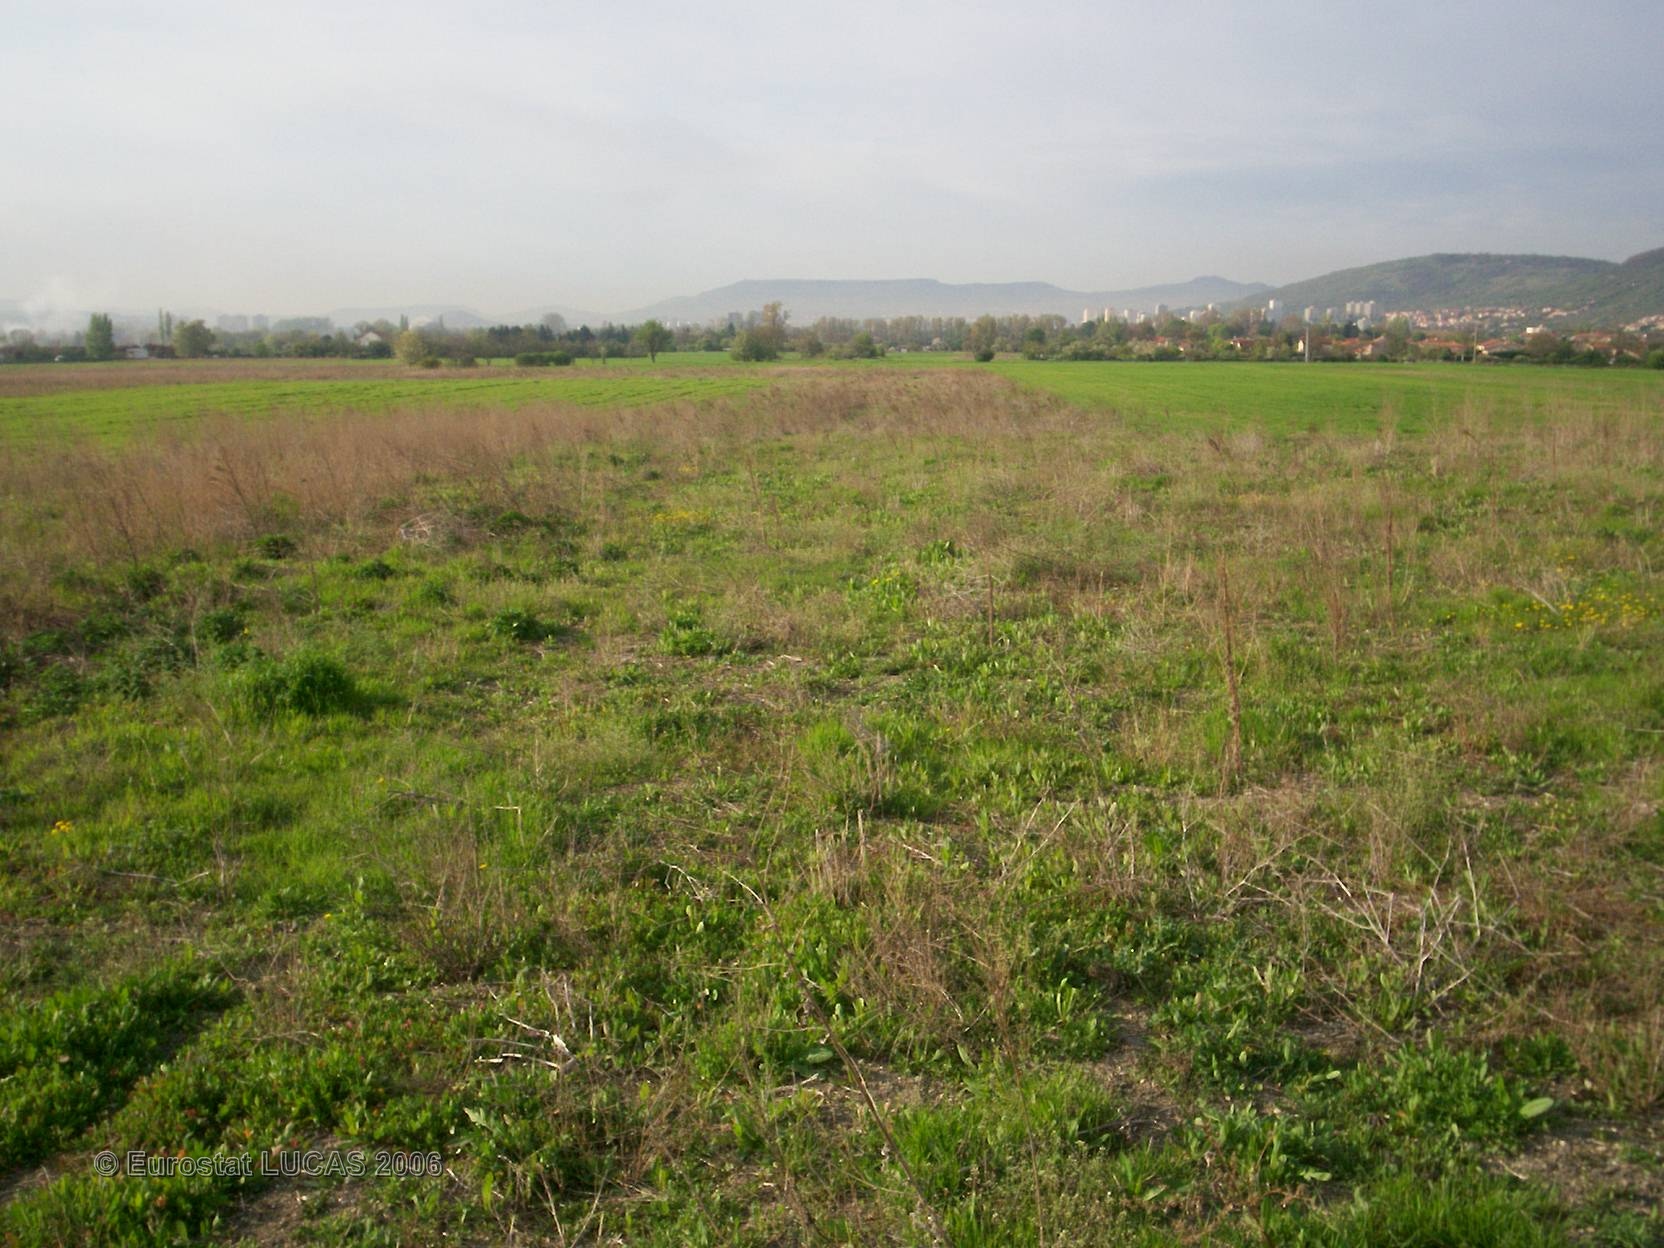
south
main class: Grassland
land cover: Grassland without tree/shrub cover
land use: Fallow land
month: April
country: FR
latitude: 45.8398
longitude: 3.1113
